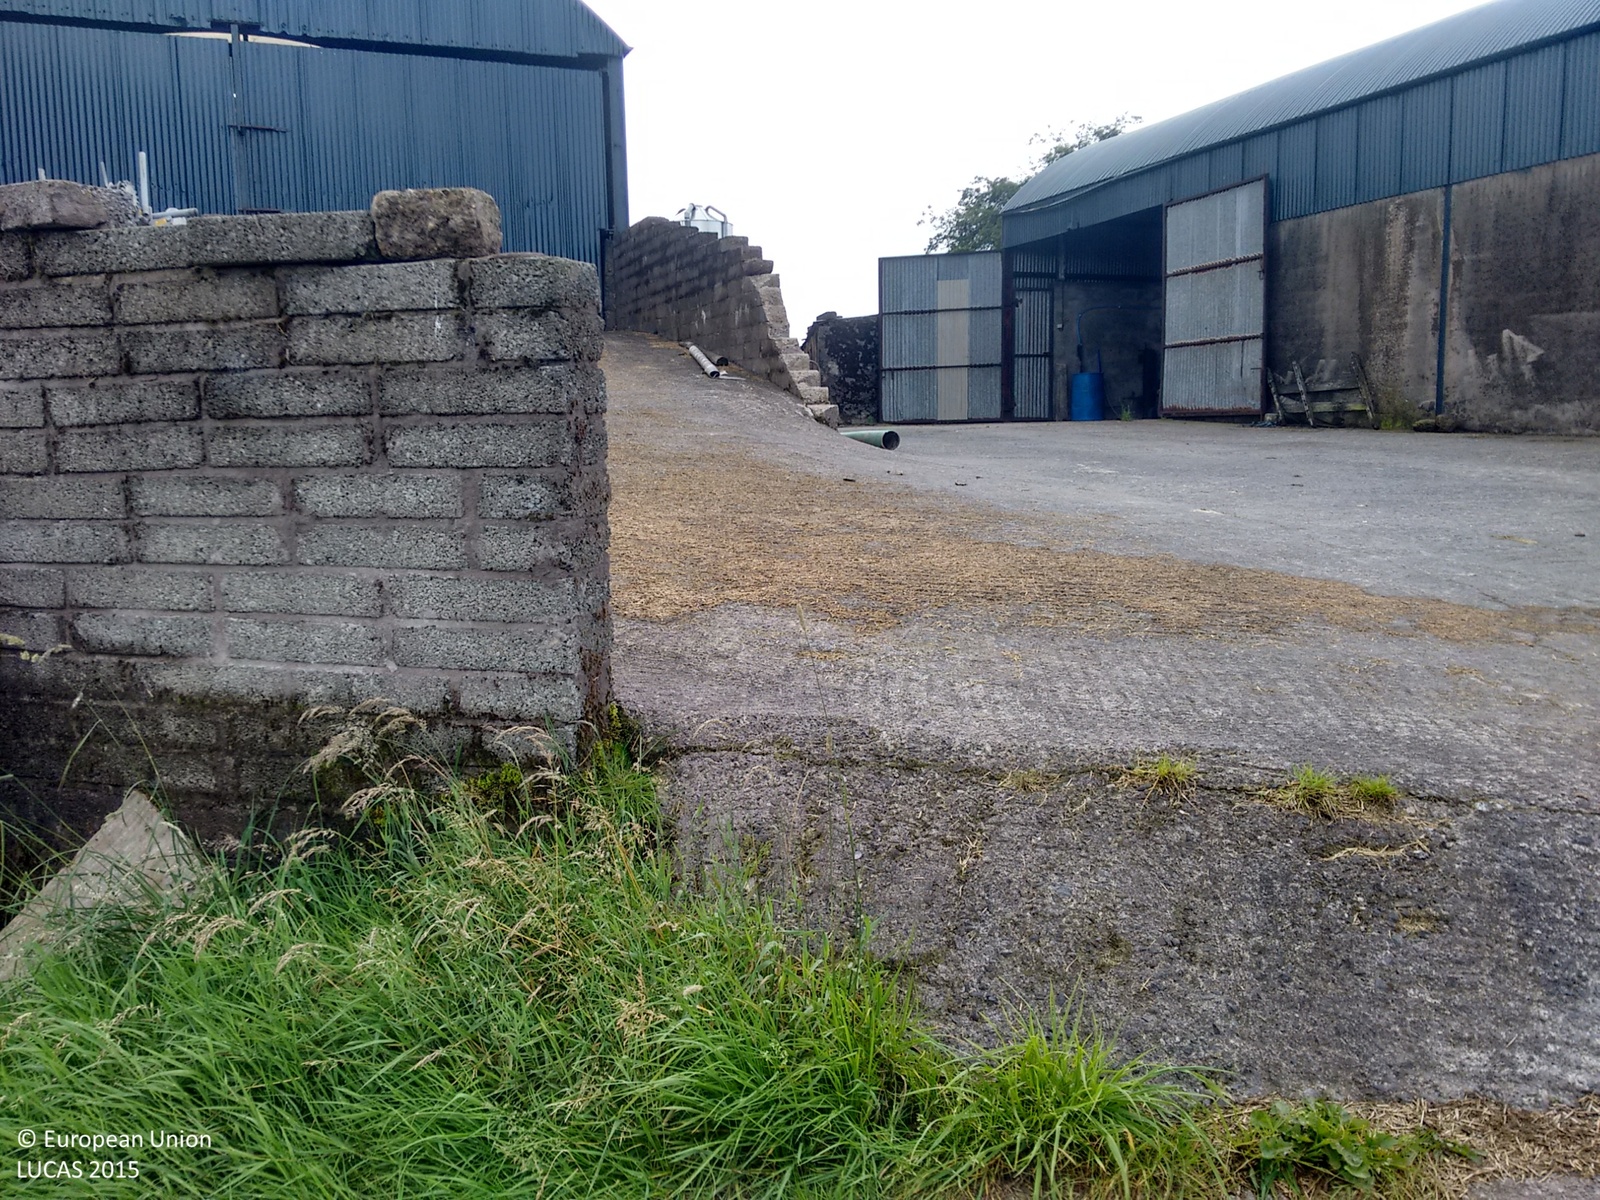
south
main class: Grassland
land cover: Grassland without tree/shrub cover
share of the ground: > 75 %
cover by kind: herbaceous plants 100 %
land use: Agriculture (excluding fallow land and kitchen gardens)
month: August
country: GB
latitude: 54.2152
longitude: -6.7084
